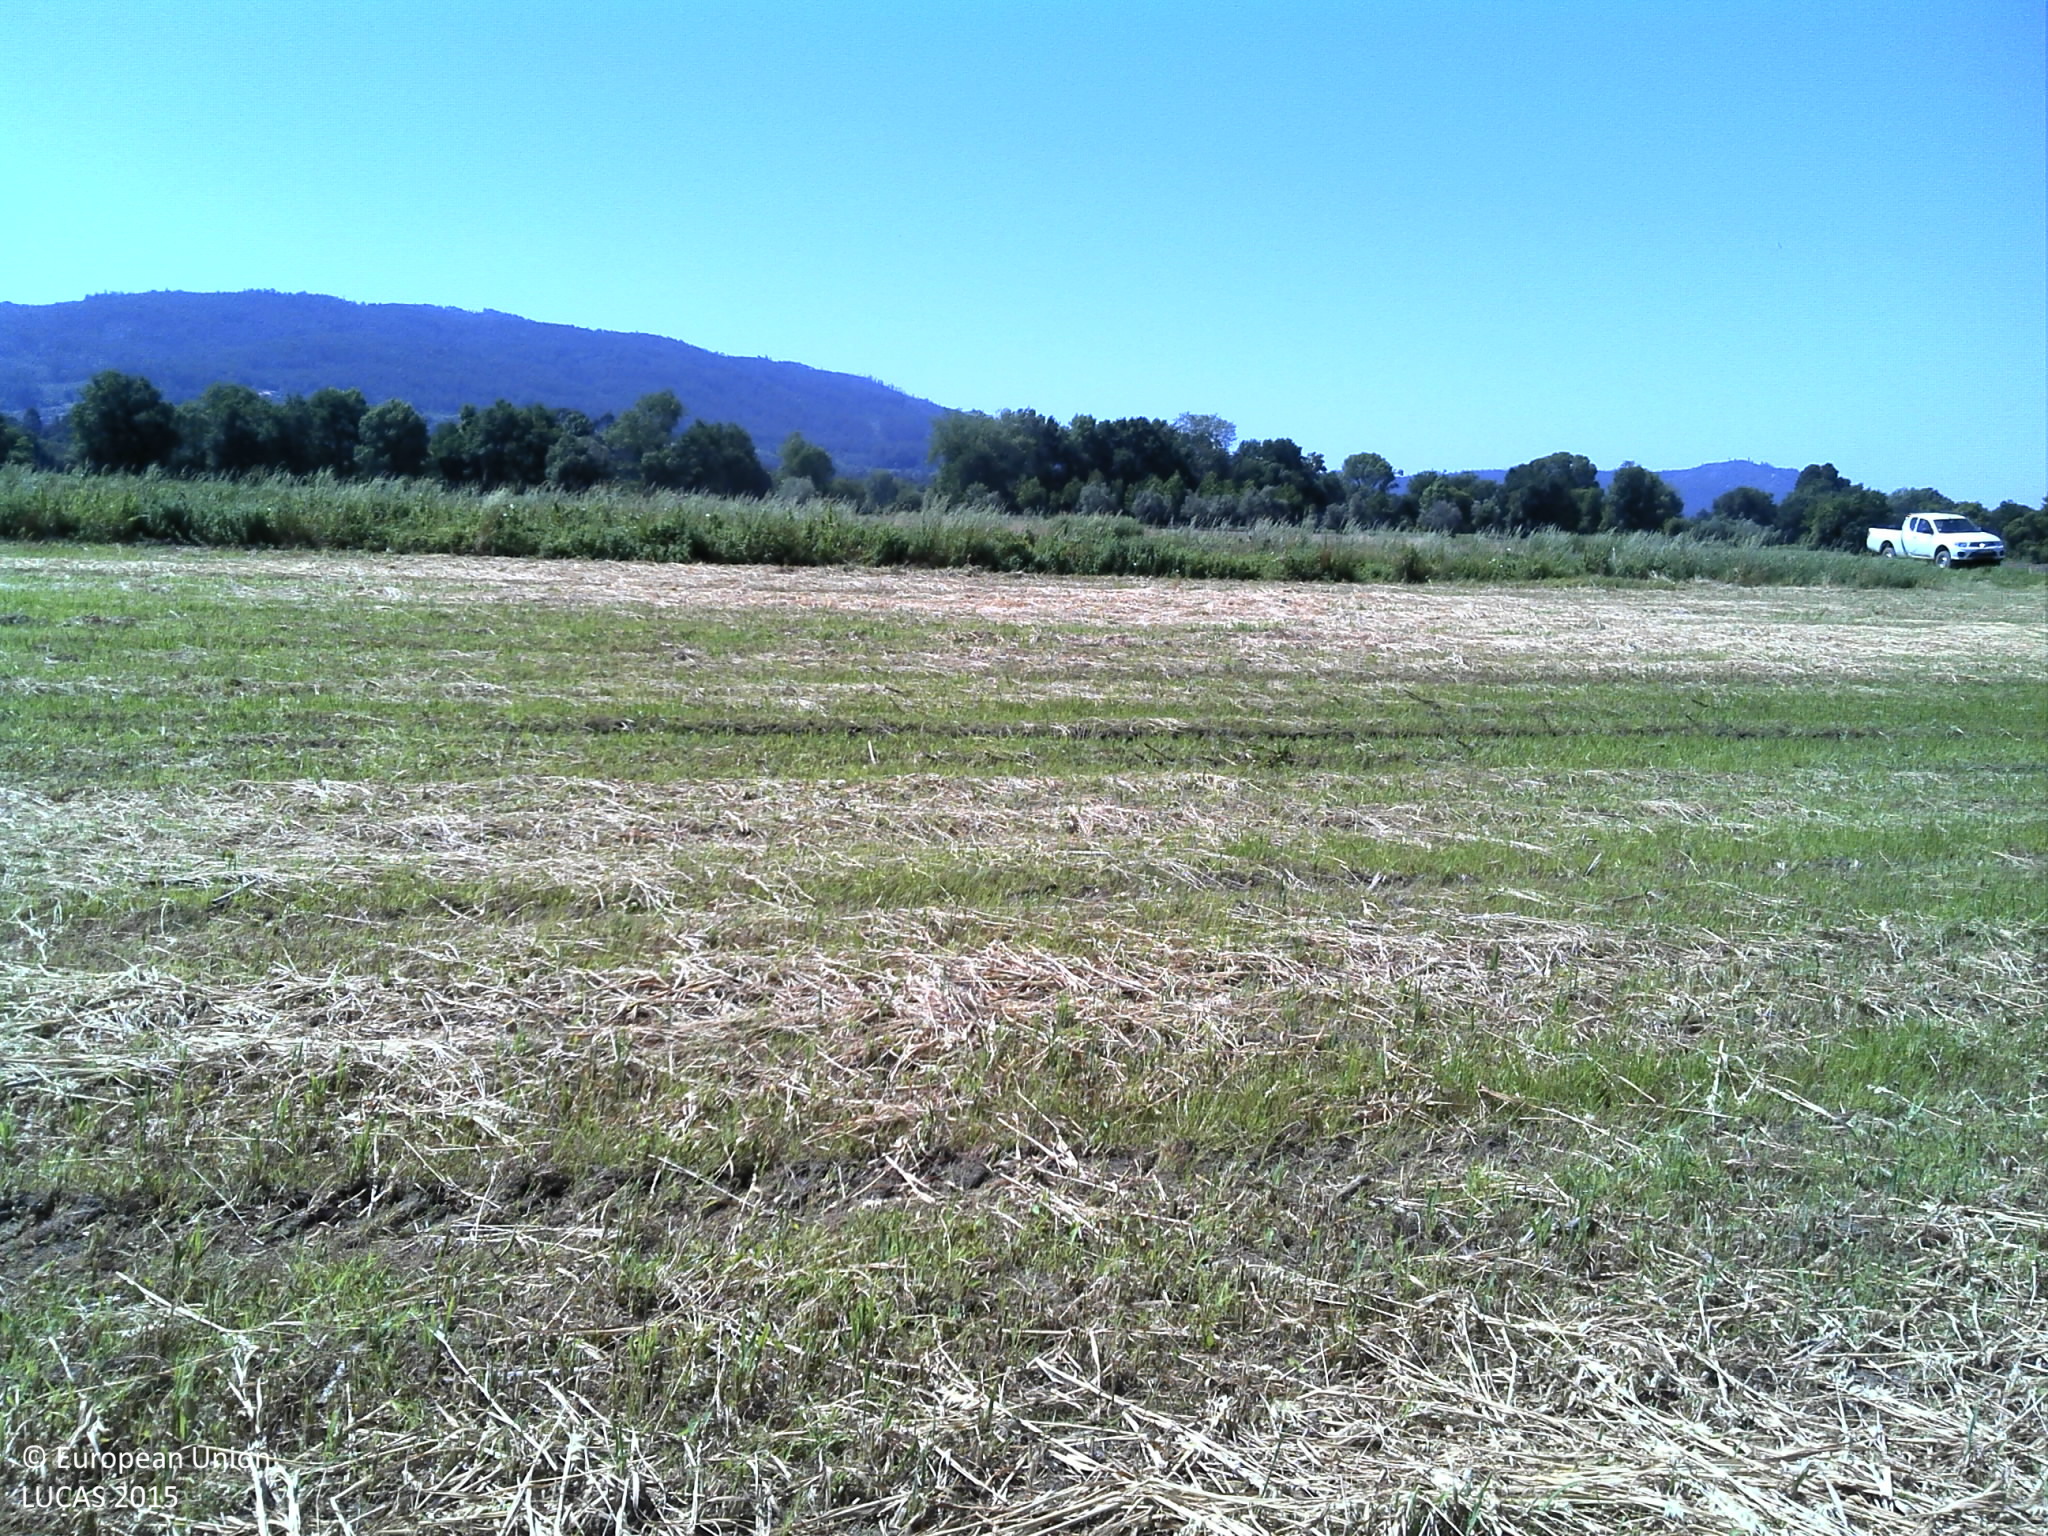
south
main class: Grassland
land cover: Spontaneously vegetated surfaces
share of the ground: < 10 %
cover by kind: unconsolidated bare surface 90 %, herbaceous plants 10 %
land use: Agriculture (excluding fallow land and kitchen gardens)
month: May
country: PT
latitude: 41.7278
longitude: -8.6902
